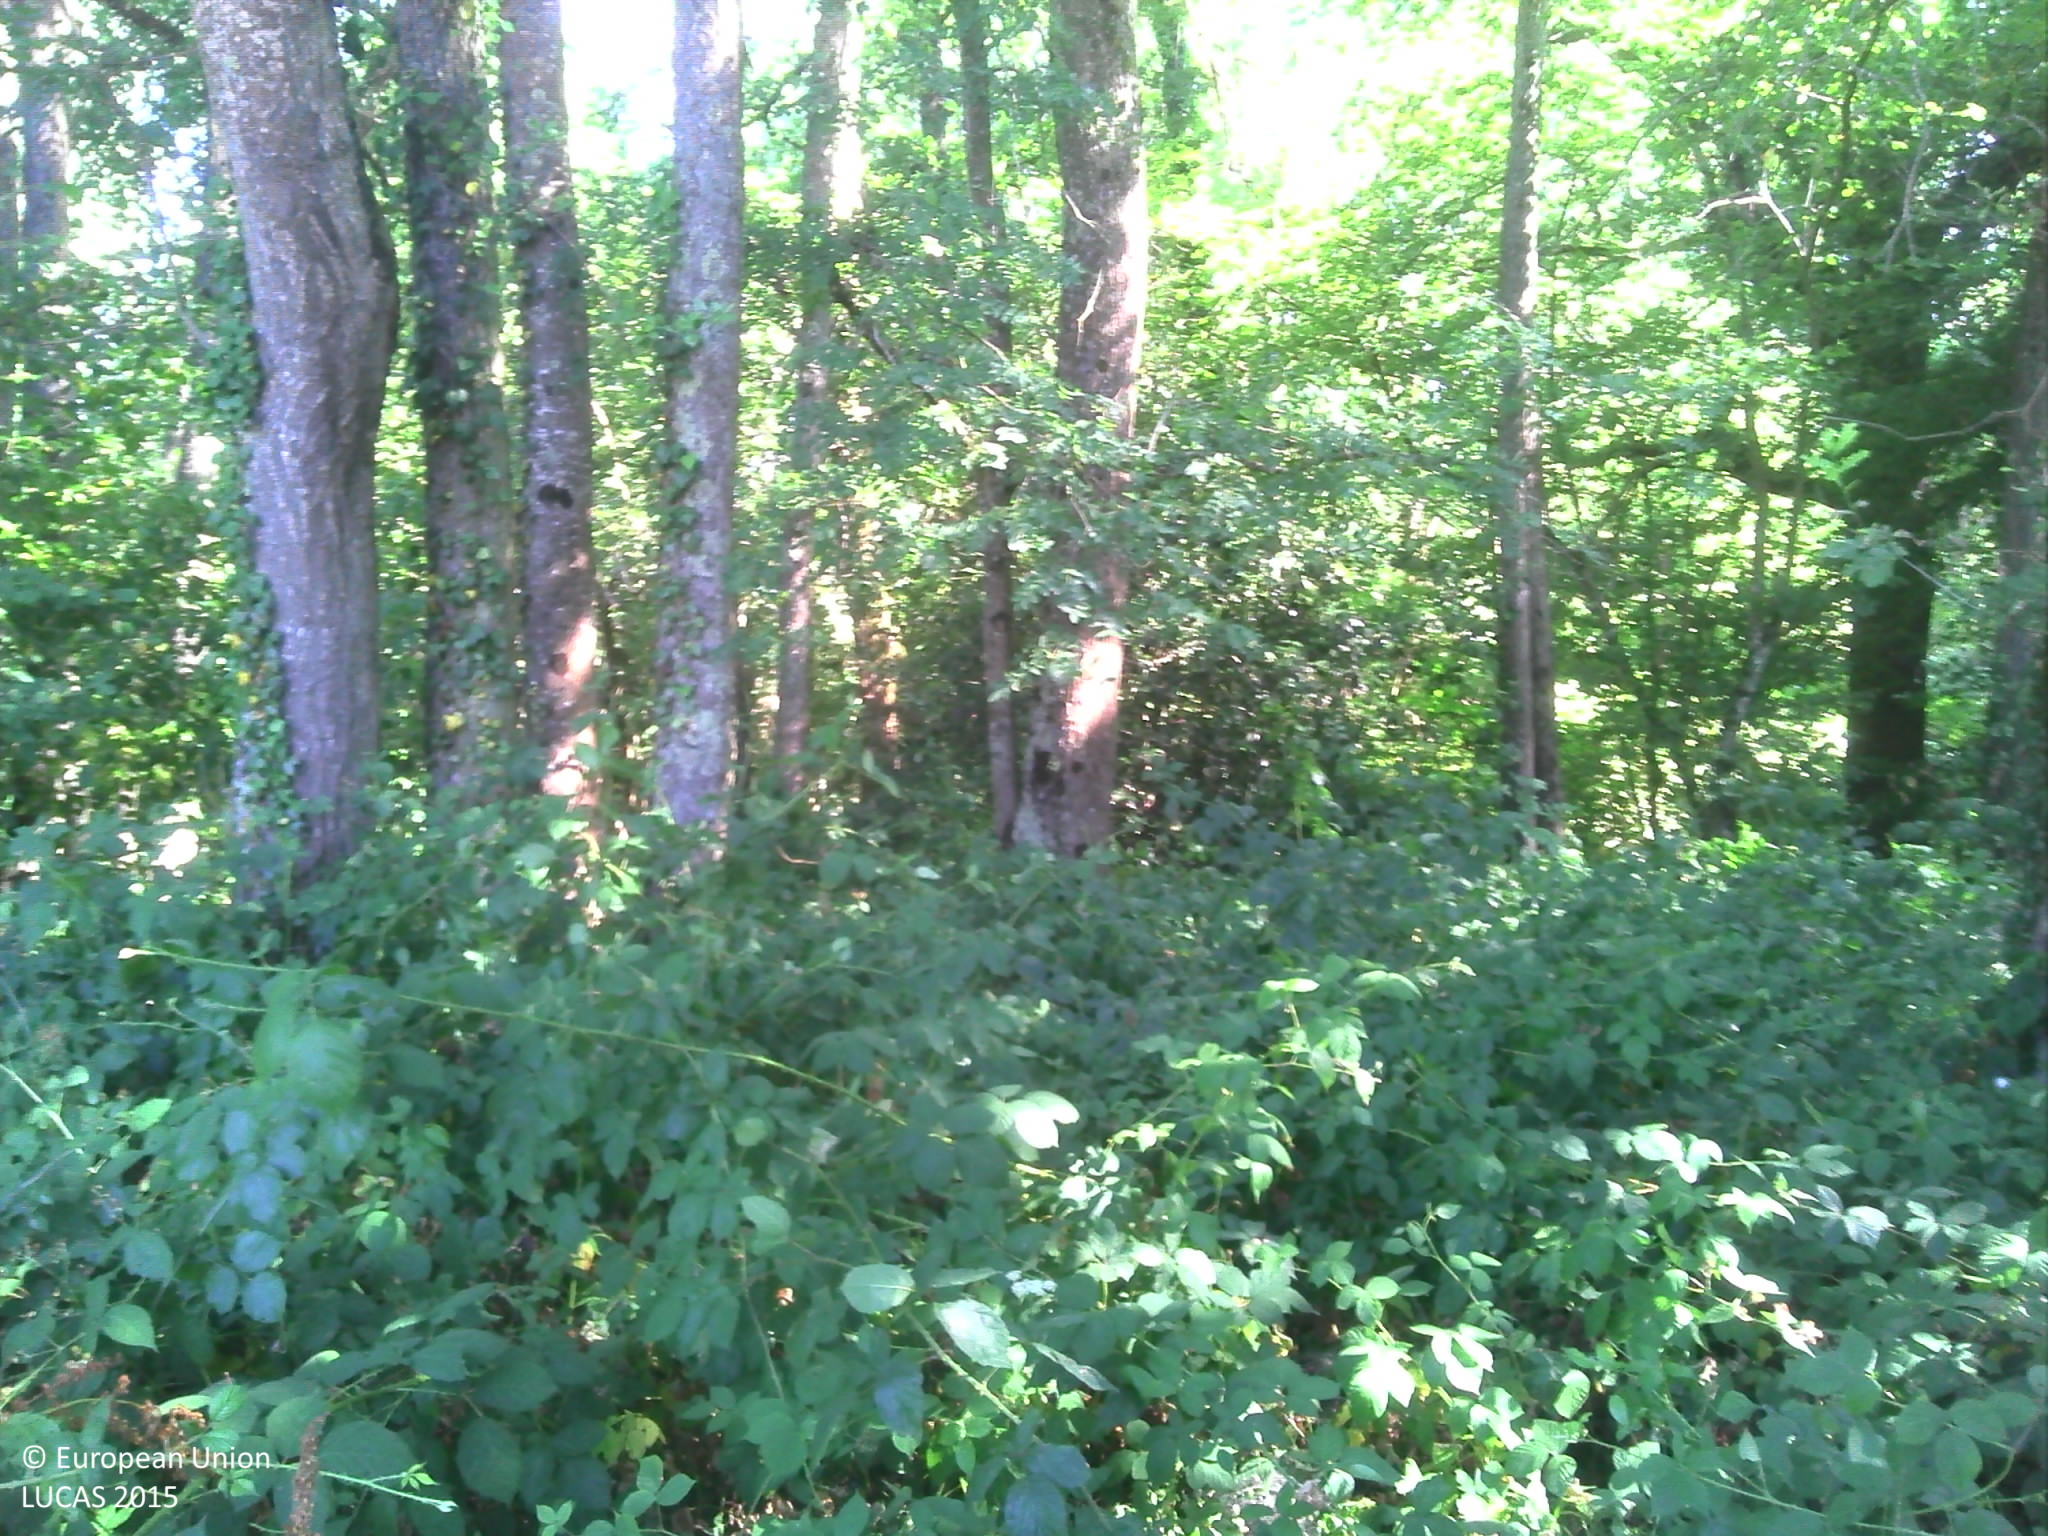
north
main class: Woodland
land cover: Broadleaved woodland
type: acidophilous oak and oak-birch forest
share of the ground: > 75 %
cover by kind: broadleaved forest trees 70 %, herbaceous plants 30 %
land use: Forestry
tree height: > 5 m
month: July
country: FR
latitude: 46.7438
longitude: 5.0934
